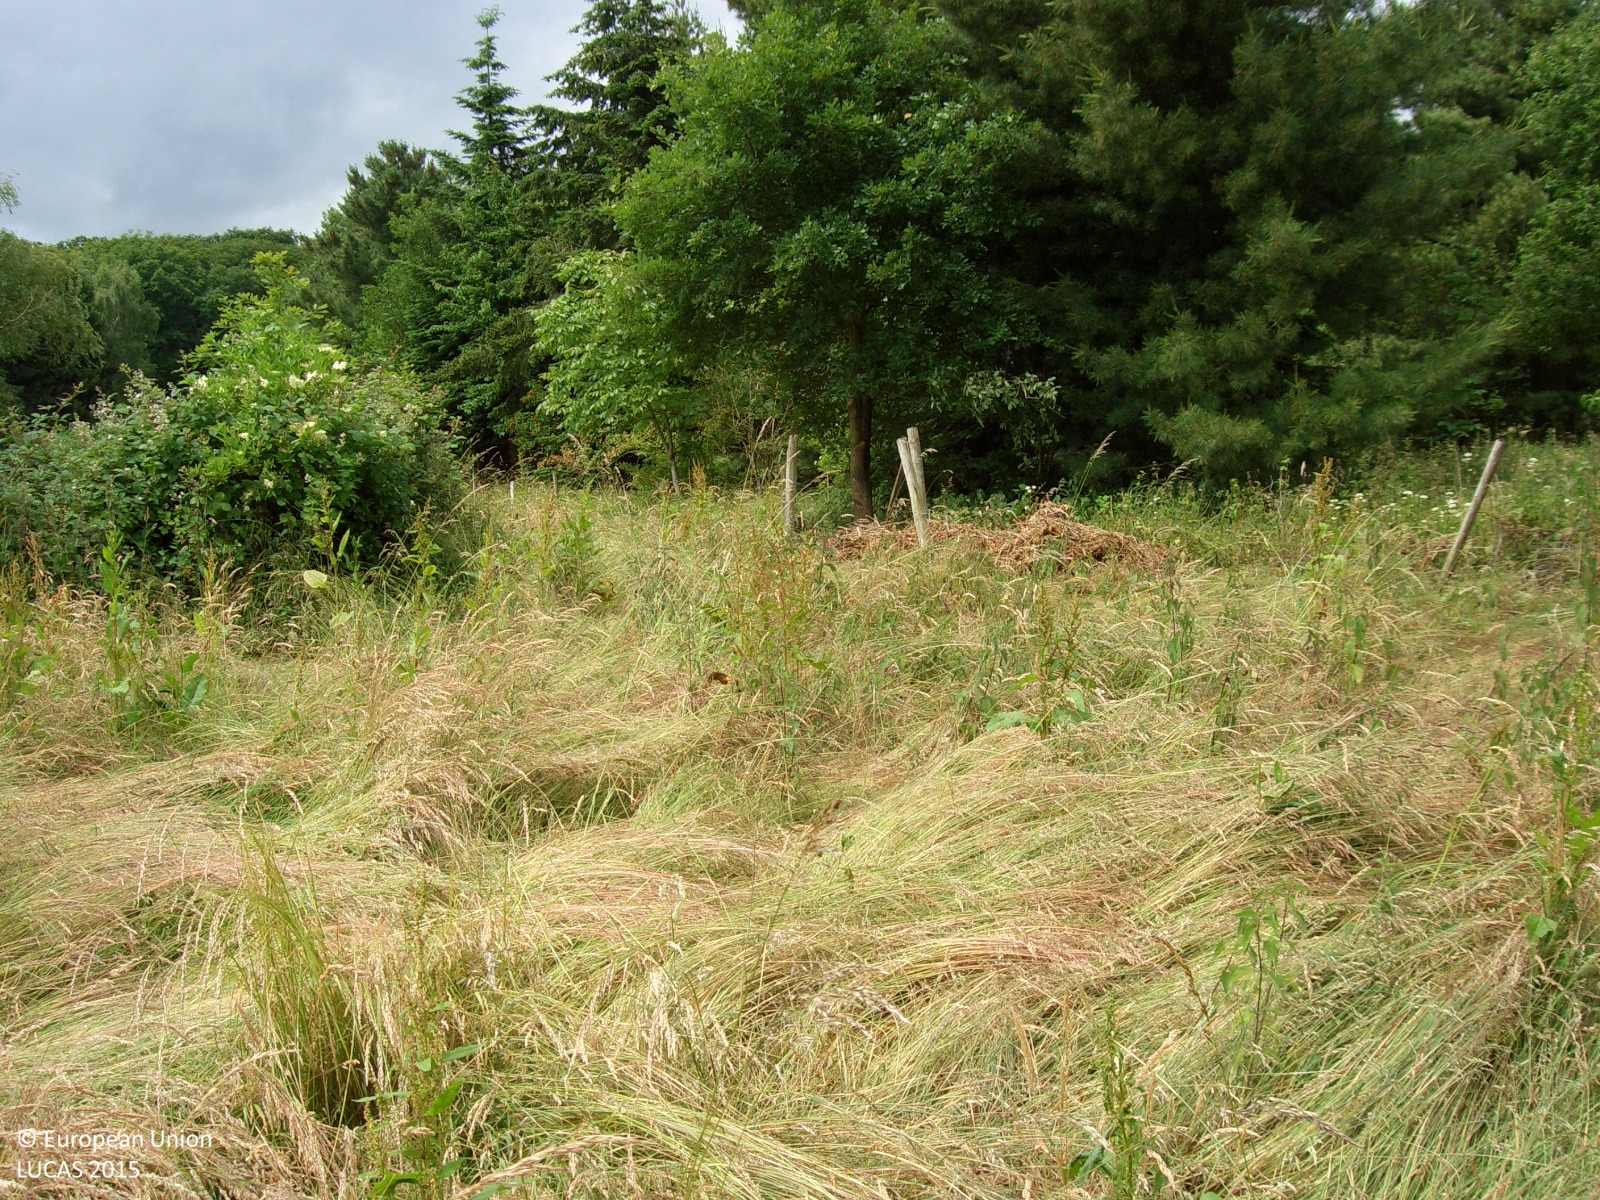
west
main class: Grassland
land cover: Grassland without tree/shrub cover
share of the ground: > 75 %
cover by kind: herbaceous plants 100 %
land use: Agriculture (excluding fallow land and kitchen gardens)
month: June
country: DE
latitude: 50.7209
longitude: 7.0113
